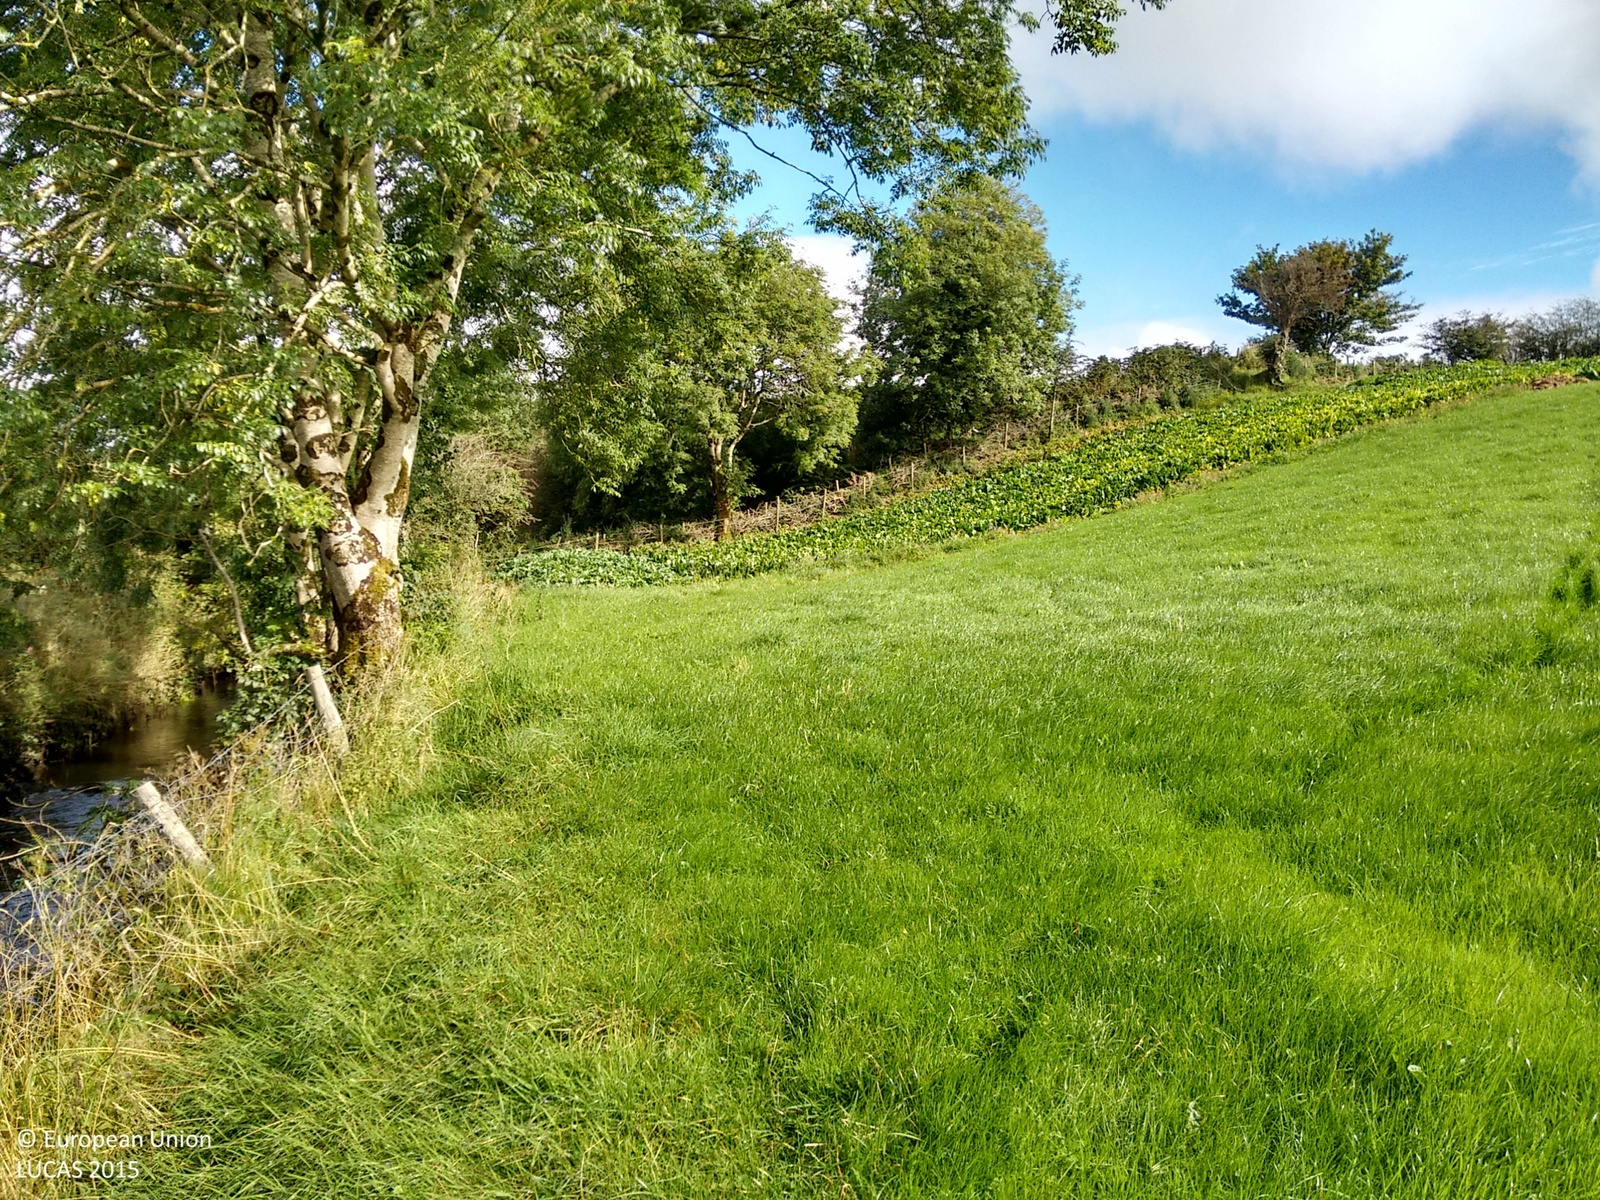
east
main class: Woodland
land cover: Broadleaved woodland
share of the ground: > 75 %
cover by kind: broadleaved forest trees 75 %, herbaceous plants 25 %
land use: Agriculture (excluding fallow land and kitchen gardens)
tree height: < 5 m
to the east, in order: Broadleaved woodland; Ditches and canals; Grassland without tree/shrub cover; Abandoned hedges; Fences; Grassland without tree/shrub cover; Broadleaved woodland; Grassland without tree/shrub cover; Inland fresh running water; Grassland with sparse tree/shrub cover; Grassland without tree/shrub cover; Broadleaved woodland; Fences
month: September
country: IE
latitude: 53.7443
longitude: -8.7778
